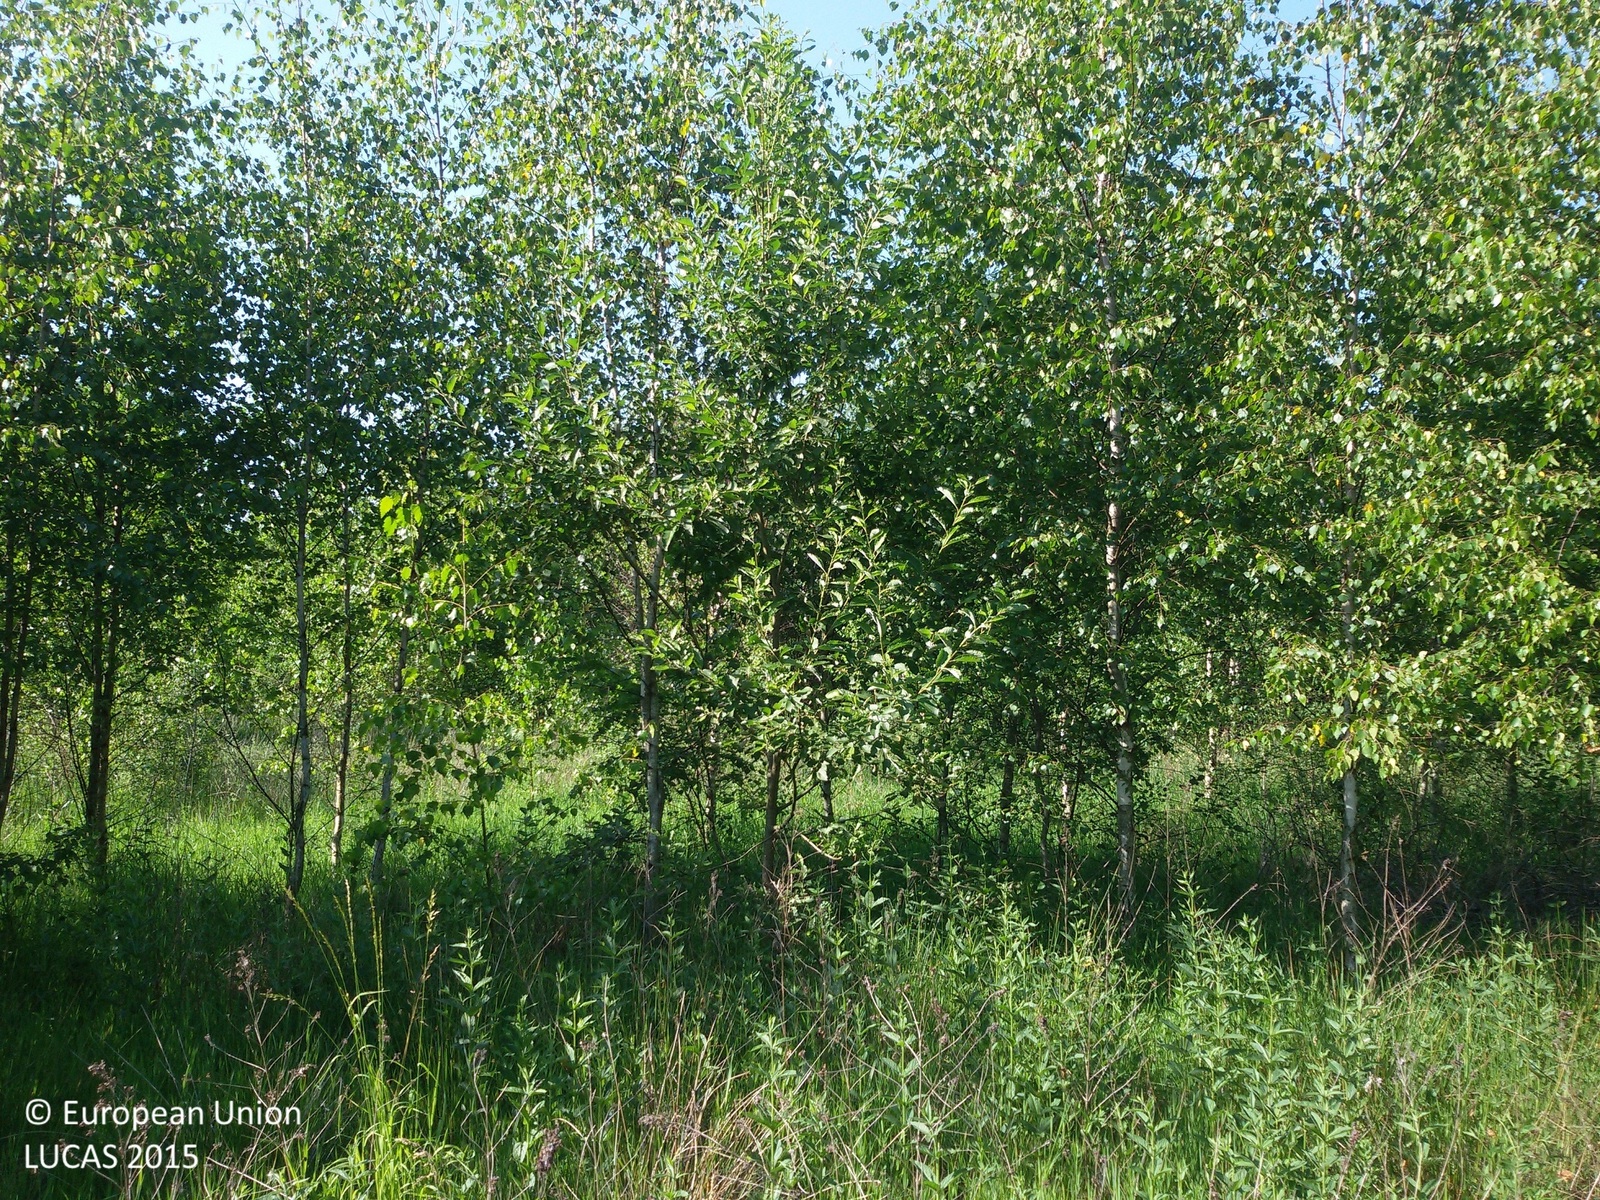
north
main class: Woodland
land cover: Broadleaved woodland
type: non-riverine alder, birch or aspen forest
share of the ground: 50 - 75 %
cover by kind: broadleaved forest trees 60 %, herbaceous plants 30 %, shrubs 10 %
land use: Forestry
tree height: < 5 m
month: June
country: PL
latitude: 51.6043
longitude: 22.9976
